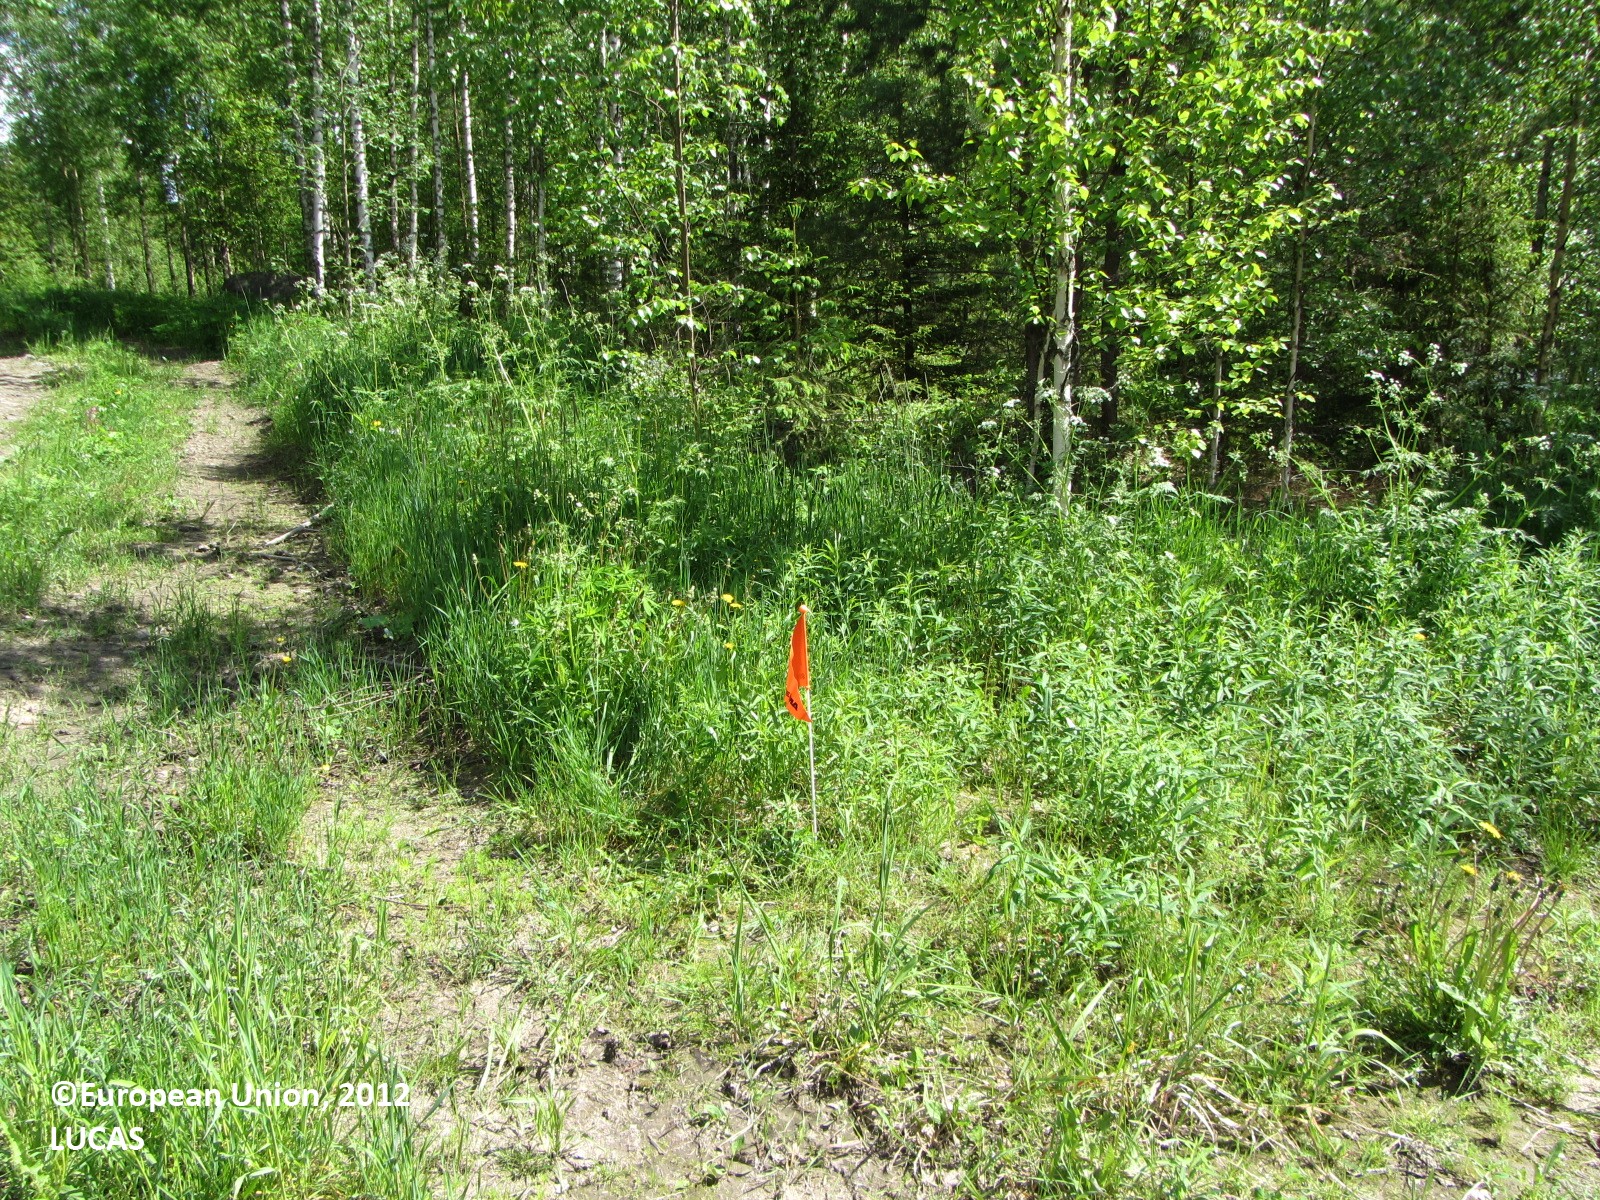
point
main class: Grassland
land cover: Spontaneously vegetated surfaces
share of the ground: 50 - 75 %
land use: Semi-natural and natural areas not in use
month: June
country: FI
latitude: 61.9953
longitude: 24.7030
